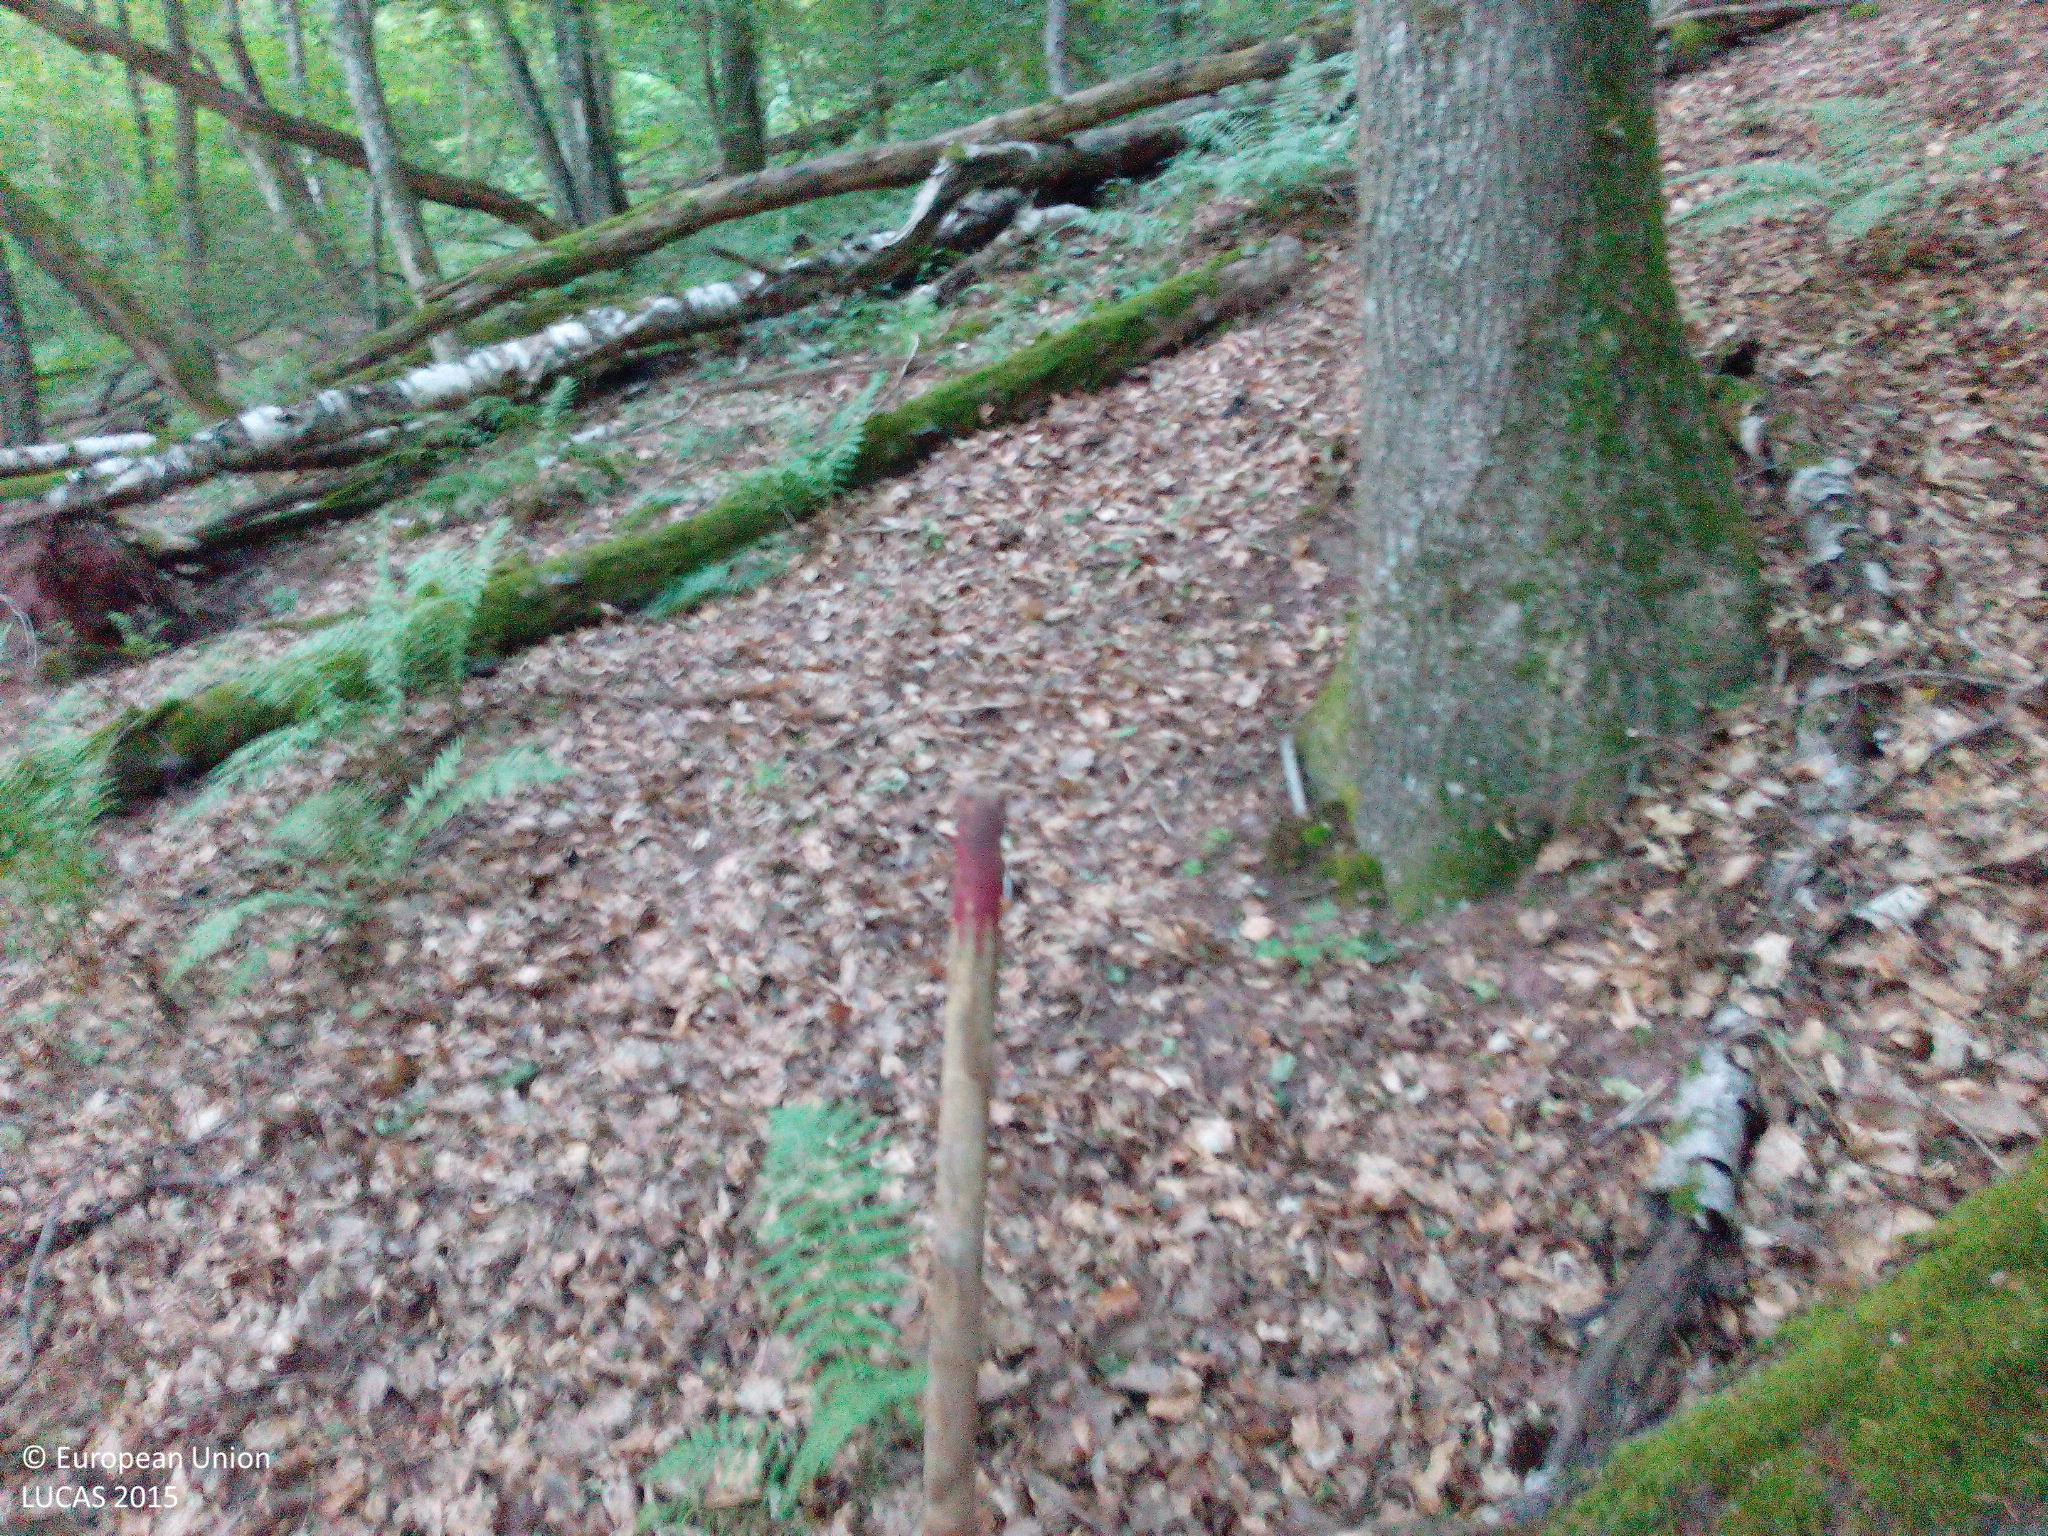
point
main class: Woodland
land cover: Broadleaved woodland
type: beech forest
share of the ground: > 75 %
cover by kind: broadleaved forest trees 90 %, unconsolidated bare surface 10 %
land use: Abandoned areas
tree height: > 5 m
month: July
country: DE
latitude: 49.1329
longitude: 7.5747
